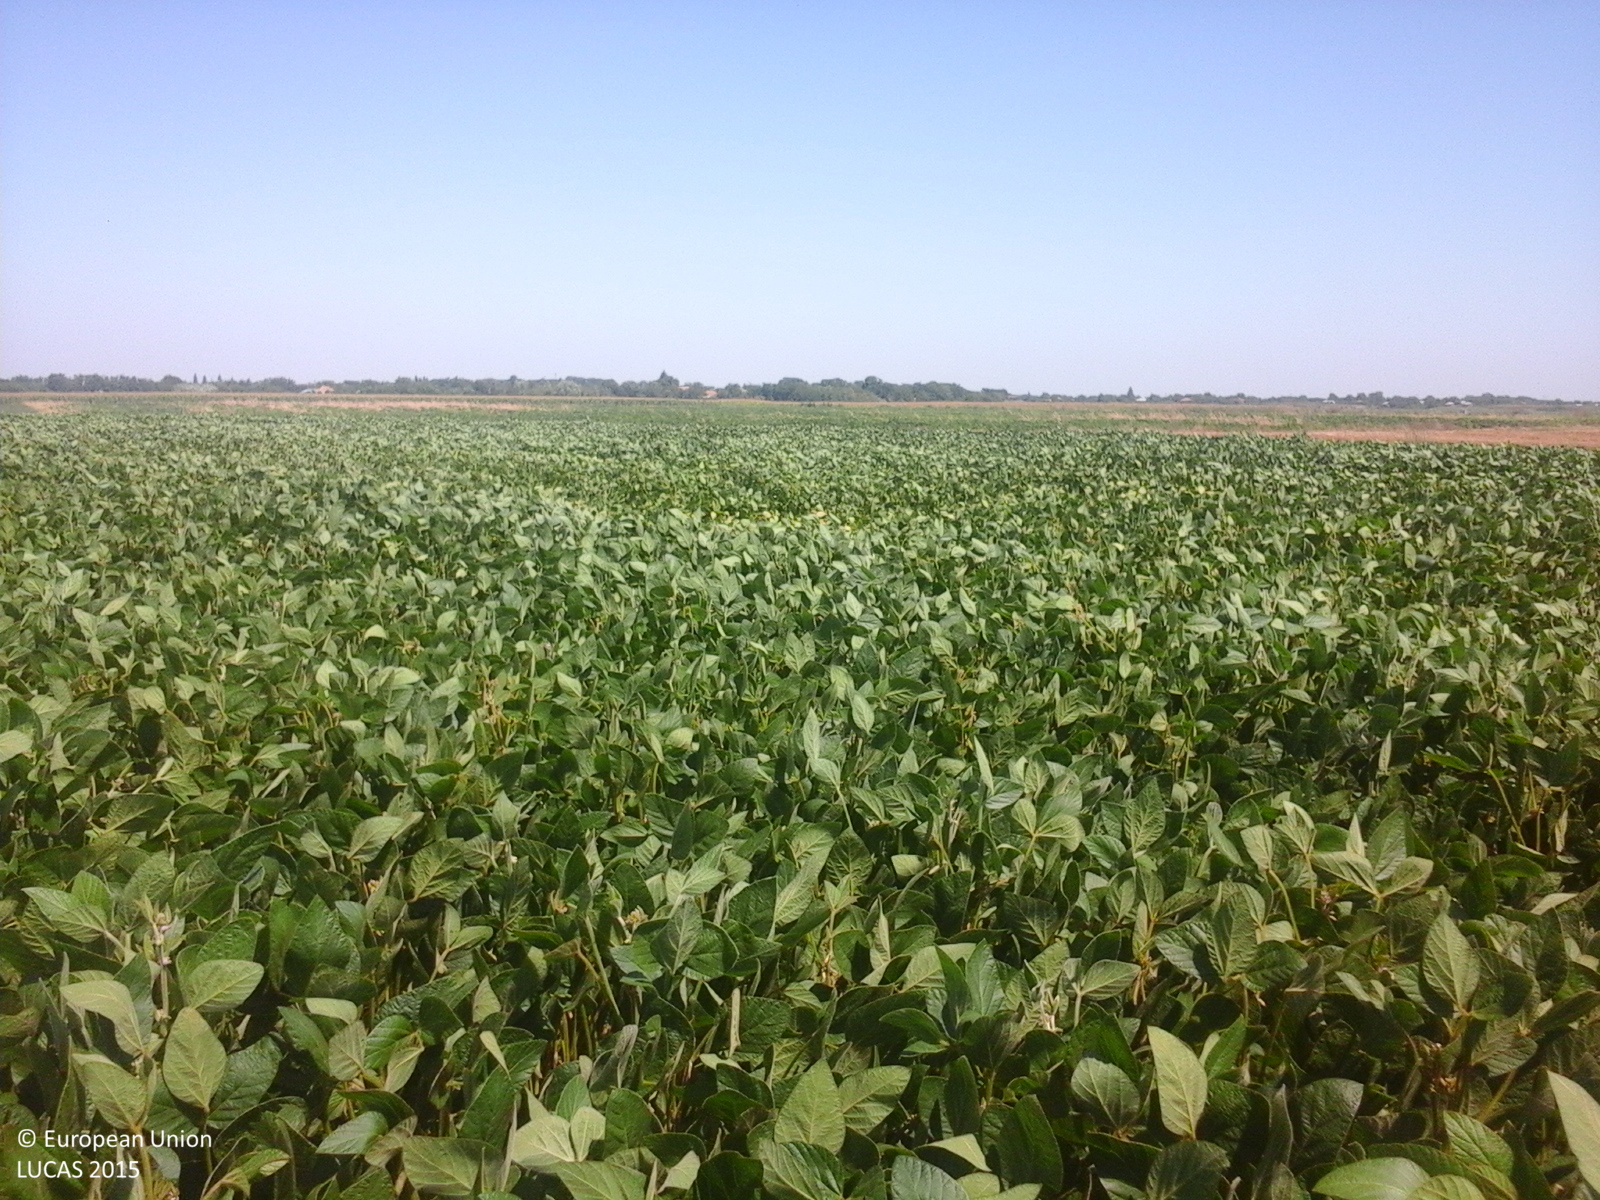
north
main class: Cropland
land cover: Soya
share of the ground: > 75 %
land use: Agriculture (excluding fallow land and kitchen gardens)
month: July
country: RO
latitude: 44.1805
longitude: 26.5887
